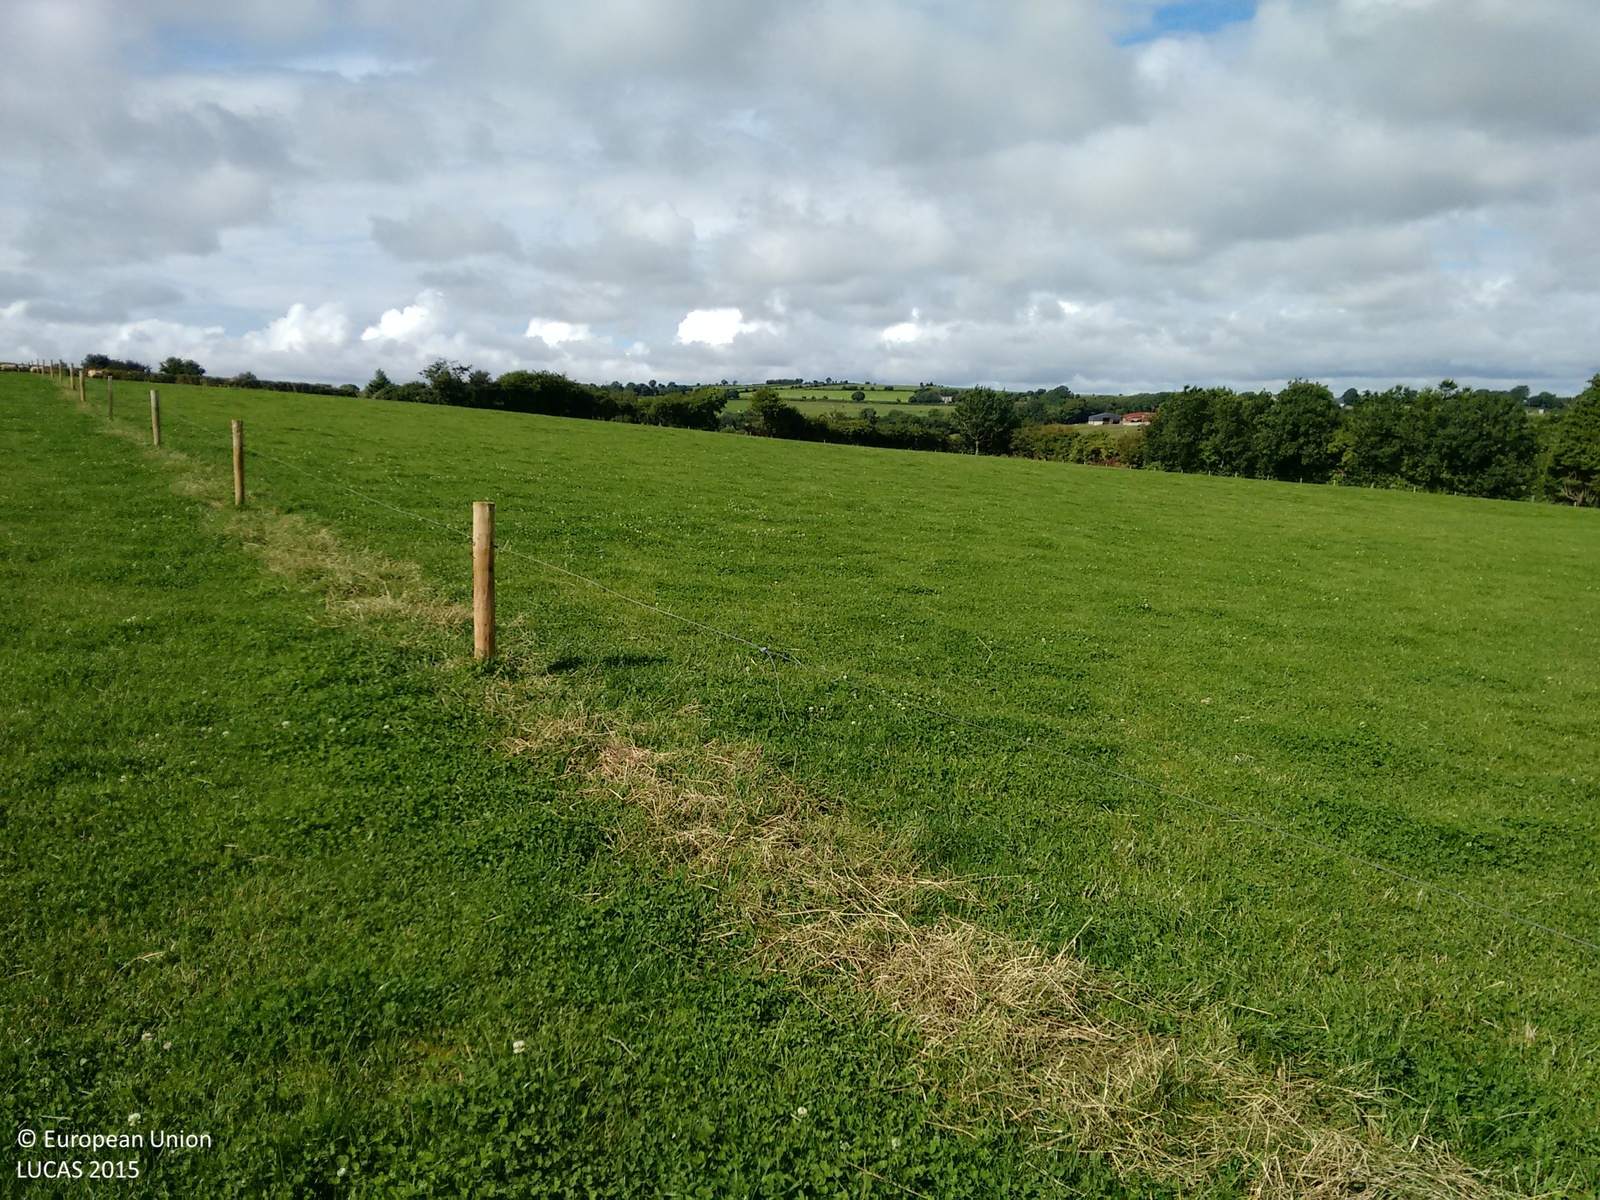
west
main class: Grassland
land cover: Grassland without tree/shrub cover
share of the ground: > 75 %
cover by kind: herbaceous plants 100 %
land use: Agriculture (excluding fallow land and kitchen gardens)
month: August
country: IE
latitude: 52.3868
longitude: -6.6320
